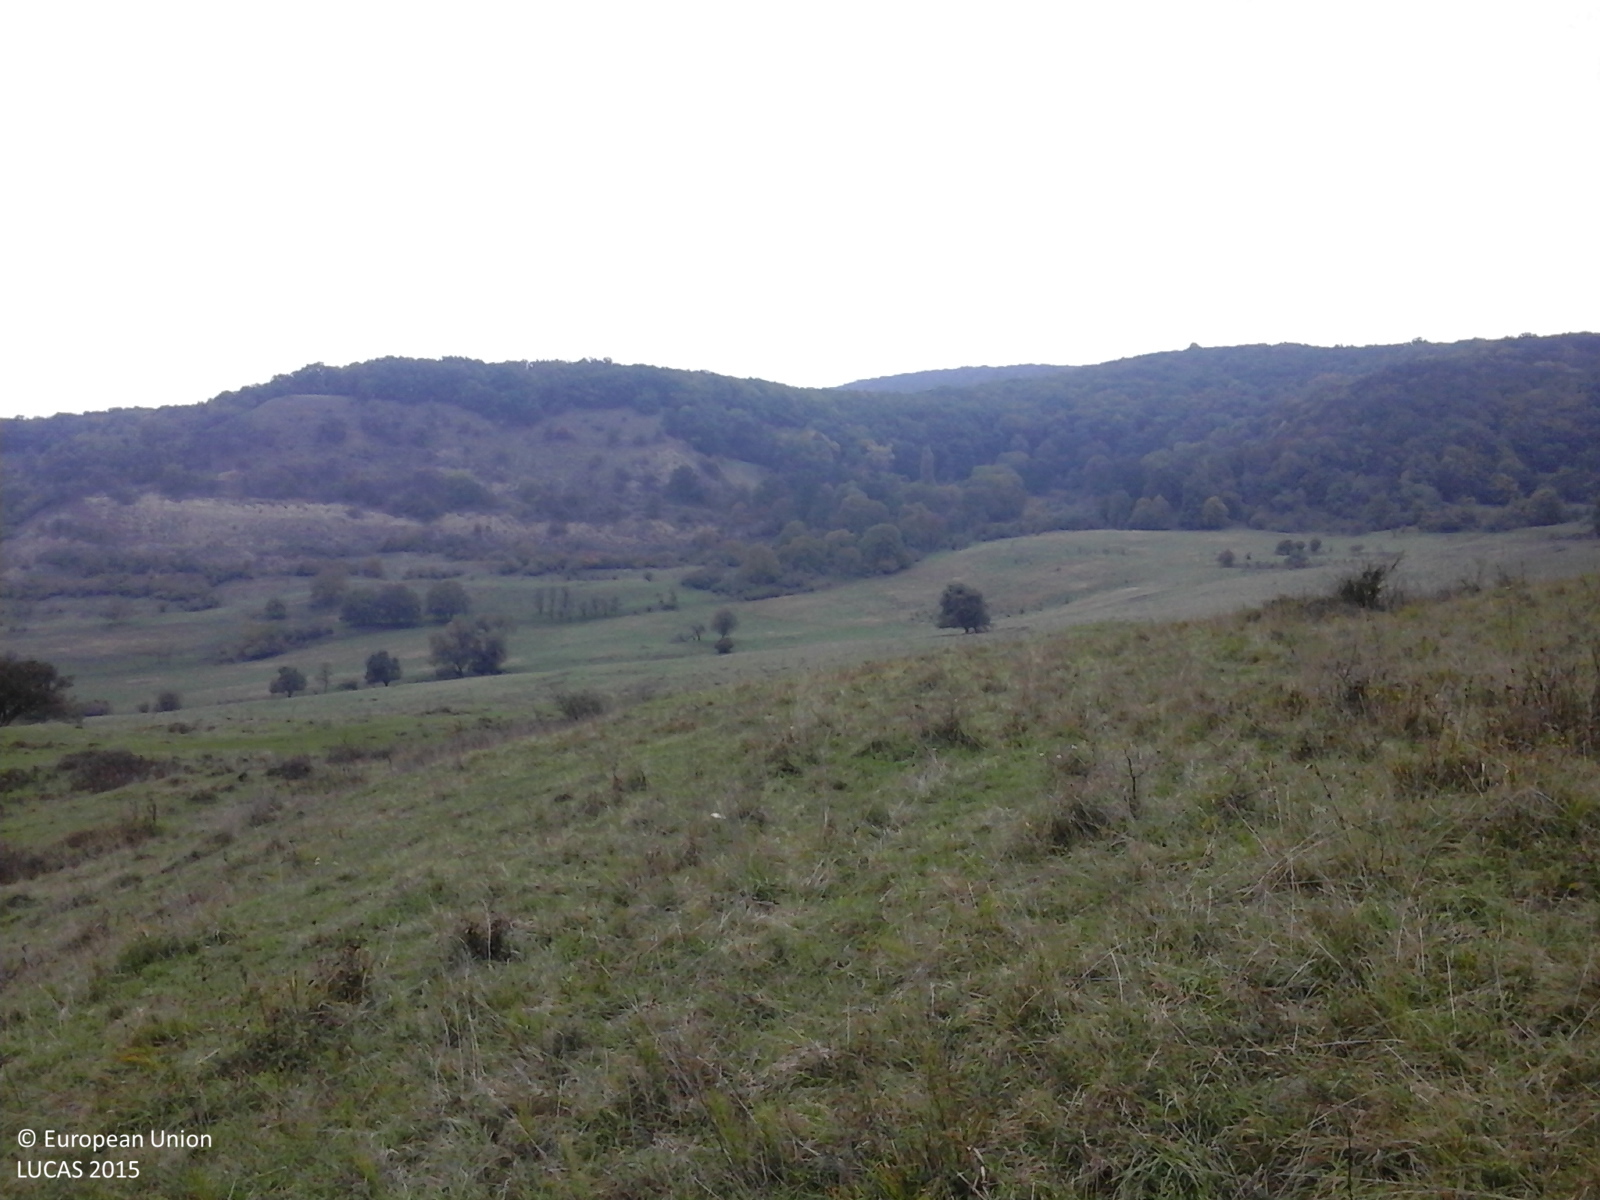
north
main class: Grassland
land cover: Grassland without tree/shrub cover
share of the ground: > 75 %
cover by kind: herbaceous plants 100 %
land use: Agriculture (excluding fallow land and kitchen gardens)
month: October
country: RO
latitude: 46.2672
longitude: 24.7919
